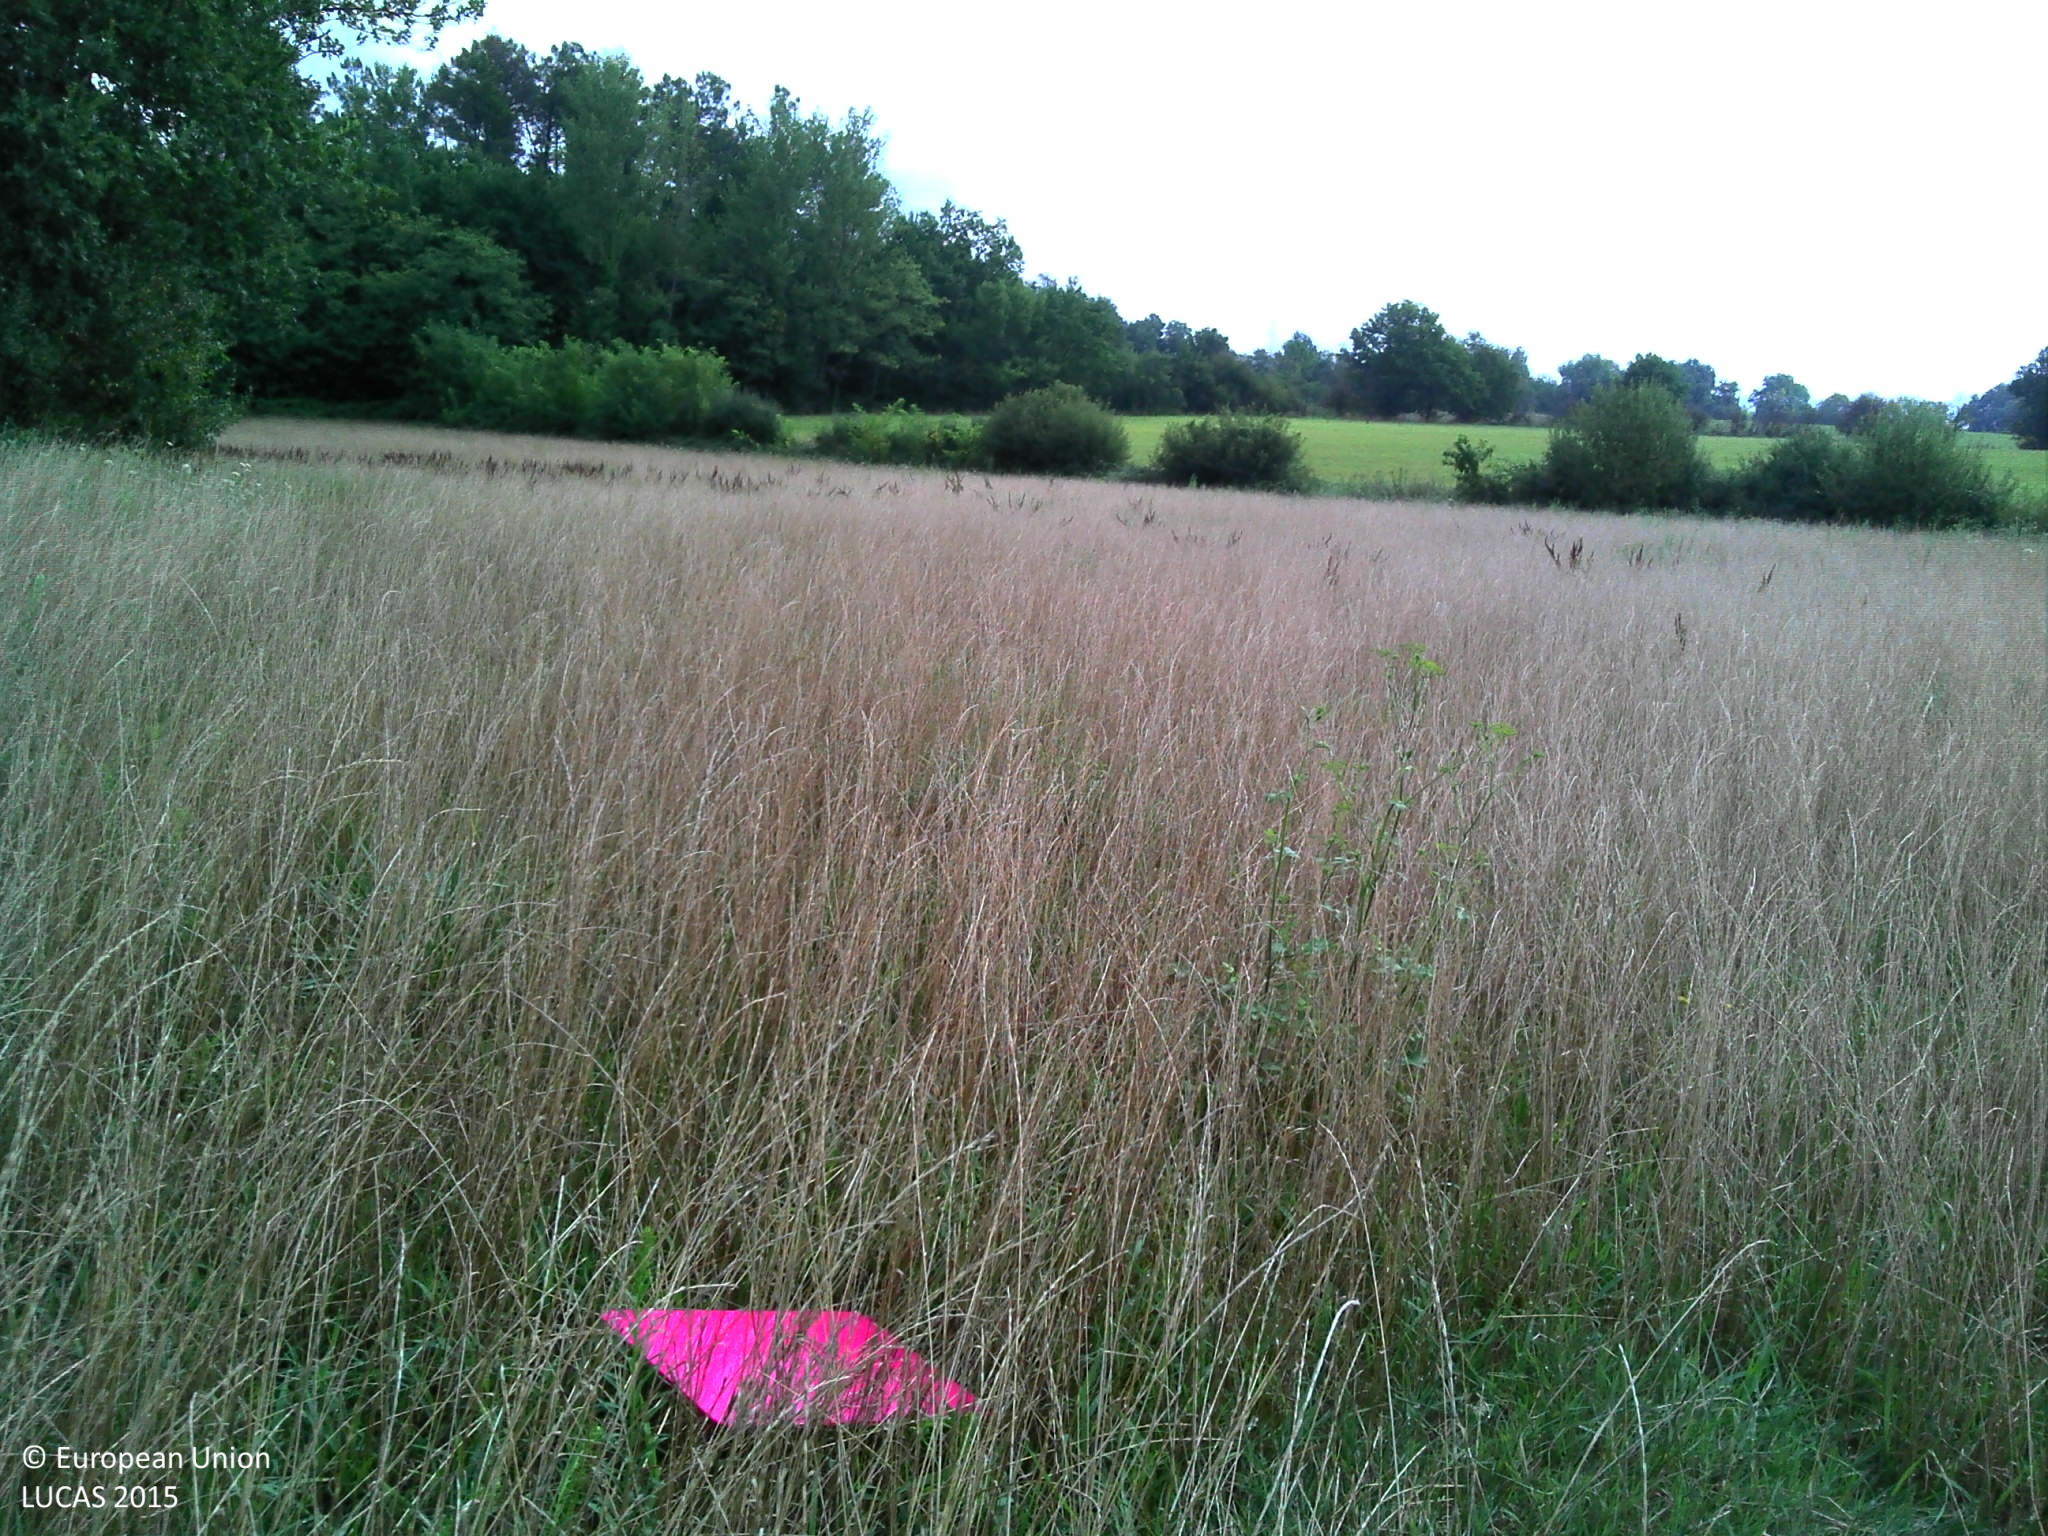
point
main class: Grassland
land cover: Grassland without tree/shrub cover
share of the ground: > 75 %
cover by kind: herbaceous plants 100 %
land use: Agriculture (excluding fallow land and kitchen gardens)
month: August
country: FR
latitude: 44.0439
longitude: 1.5768
